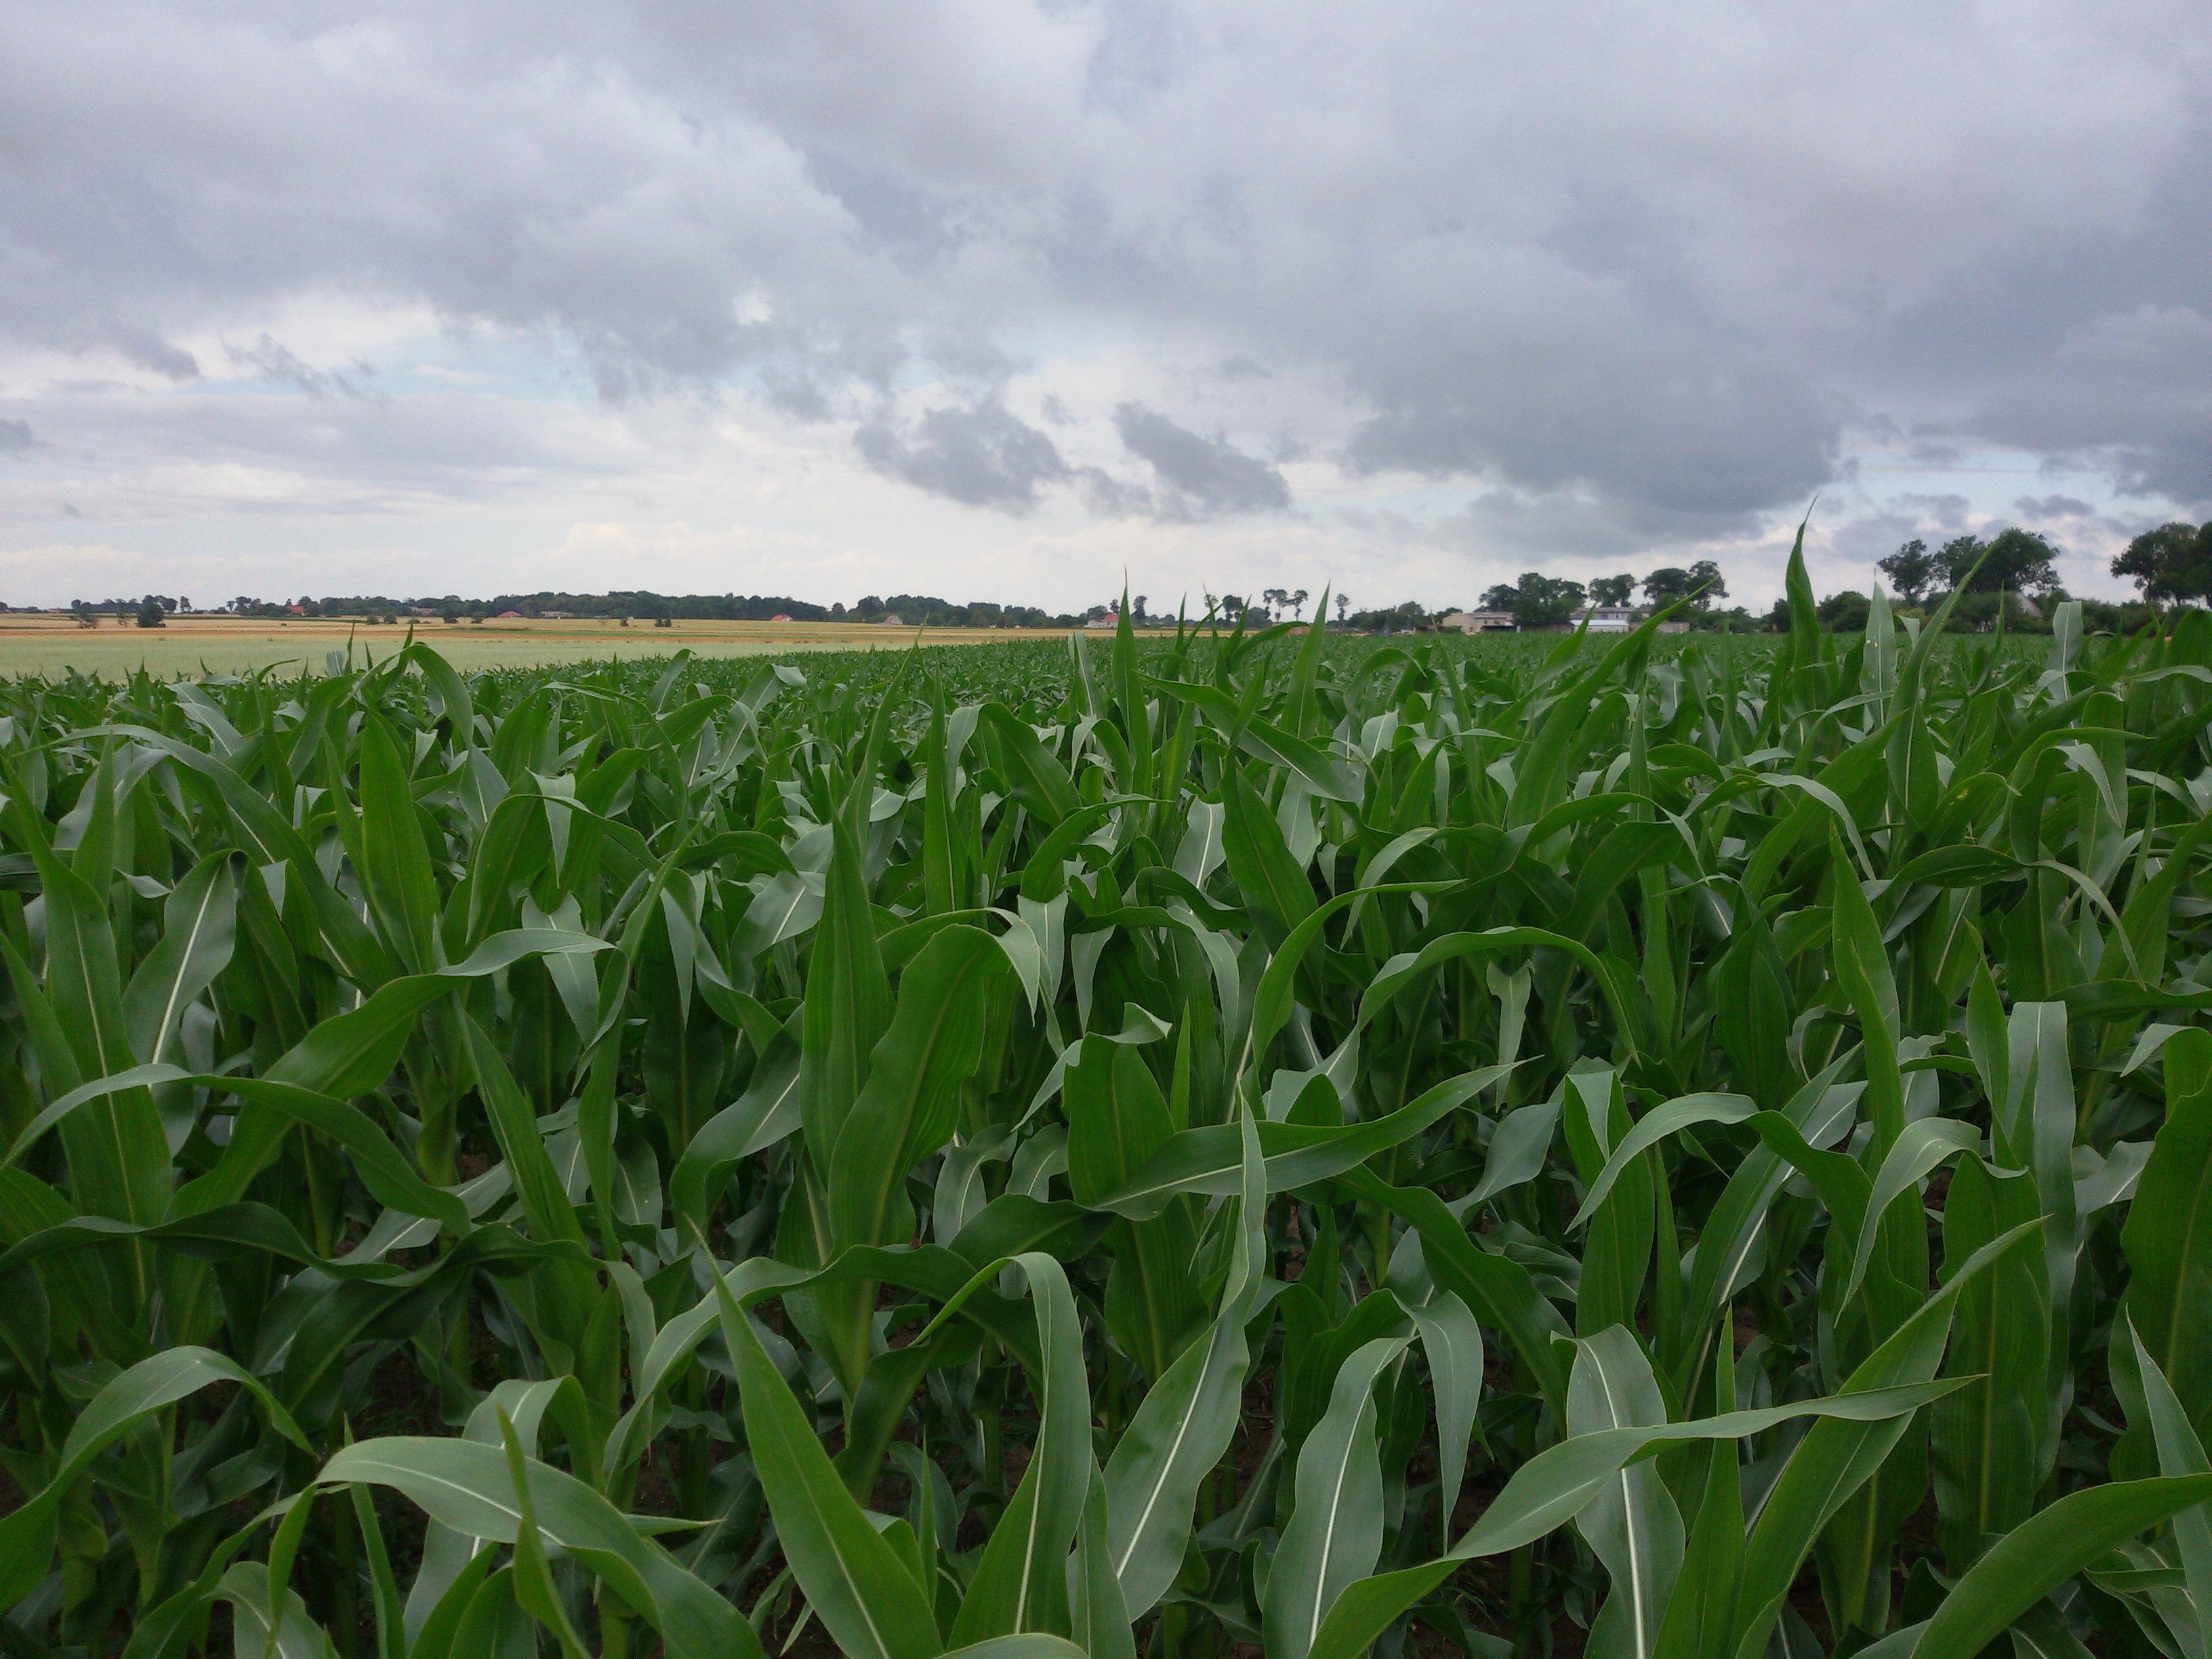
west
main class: Cropland
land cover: Maize
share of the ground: > 75 %
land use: Agriculture (excluding fallow land and kitchen gardens)
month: July
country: PL
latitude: 52.8540
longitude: 17.6313
